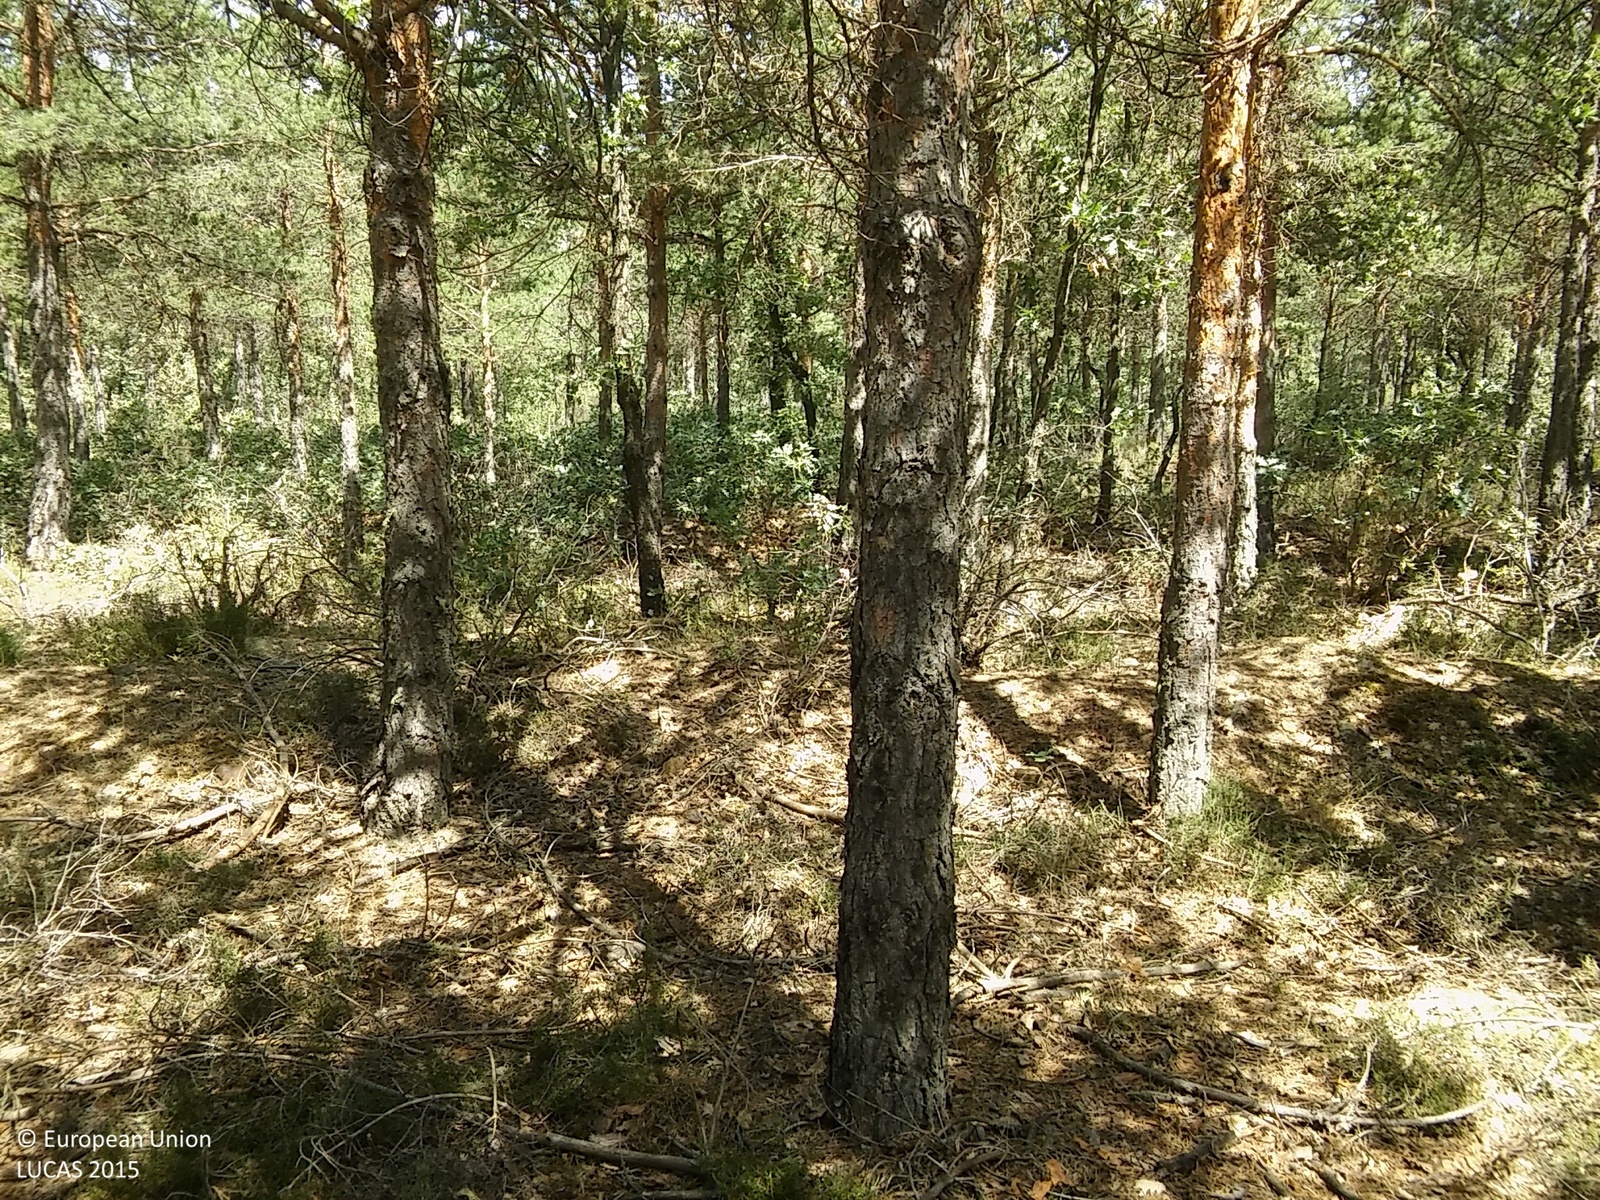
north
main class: Woodland
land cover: Pine dominated coniferous woodland
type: coniferous forest of the mediterranean region
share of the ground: 50 - 75 %
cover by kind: coniferous forest trees 70 %, shrubs 15 %, herbaceous plants 10 %, unconsolidated bare surface 5 %
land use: Forestry
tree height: > 5 m
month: August
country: ES
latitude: 41.3235
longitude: -3.5105
